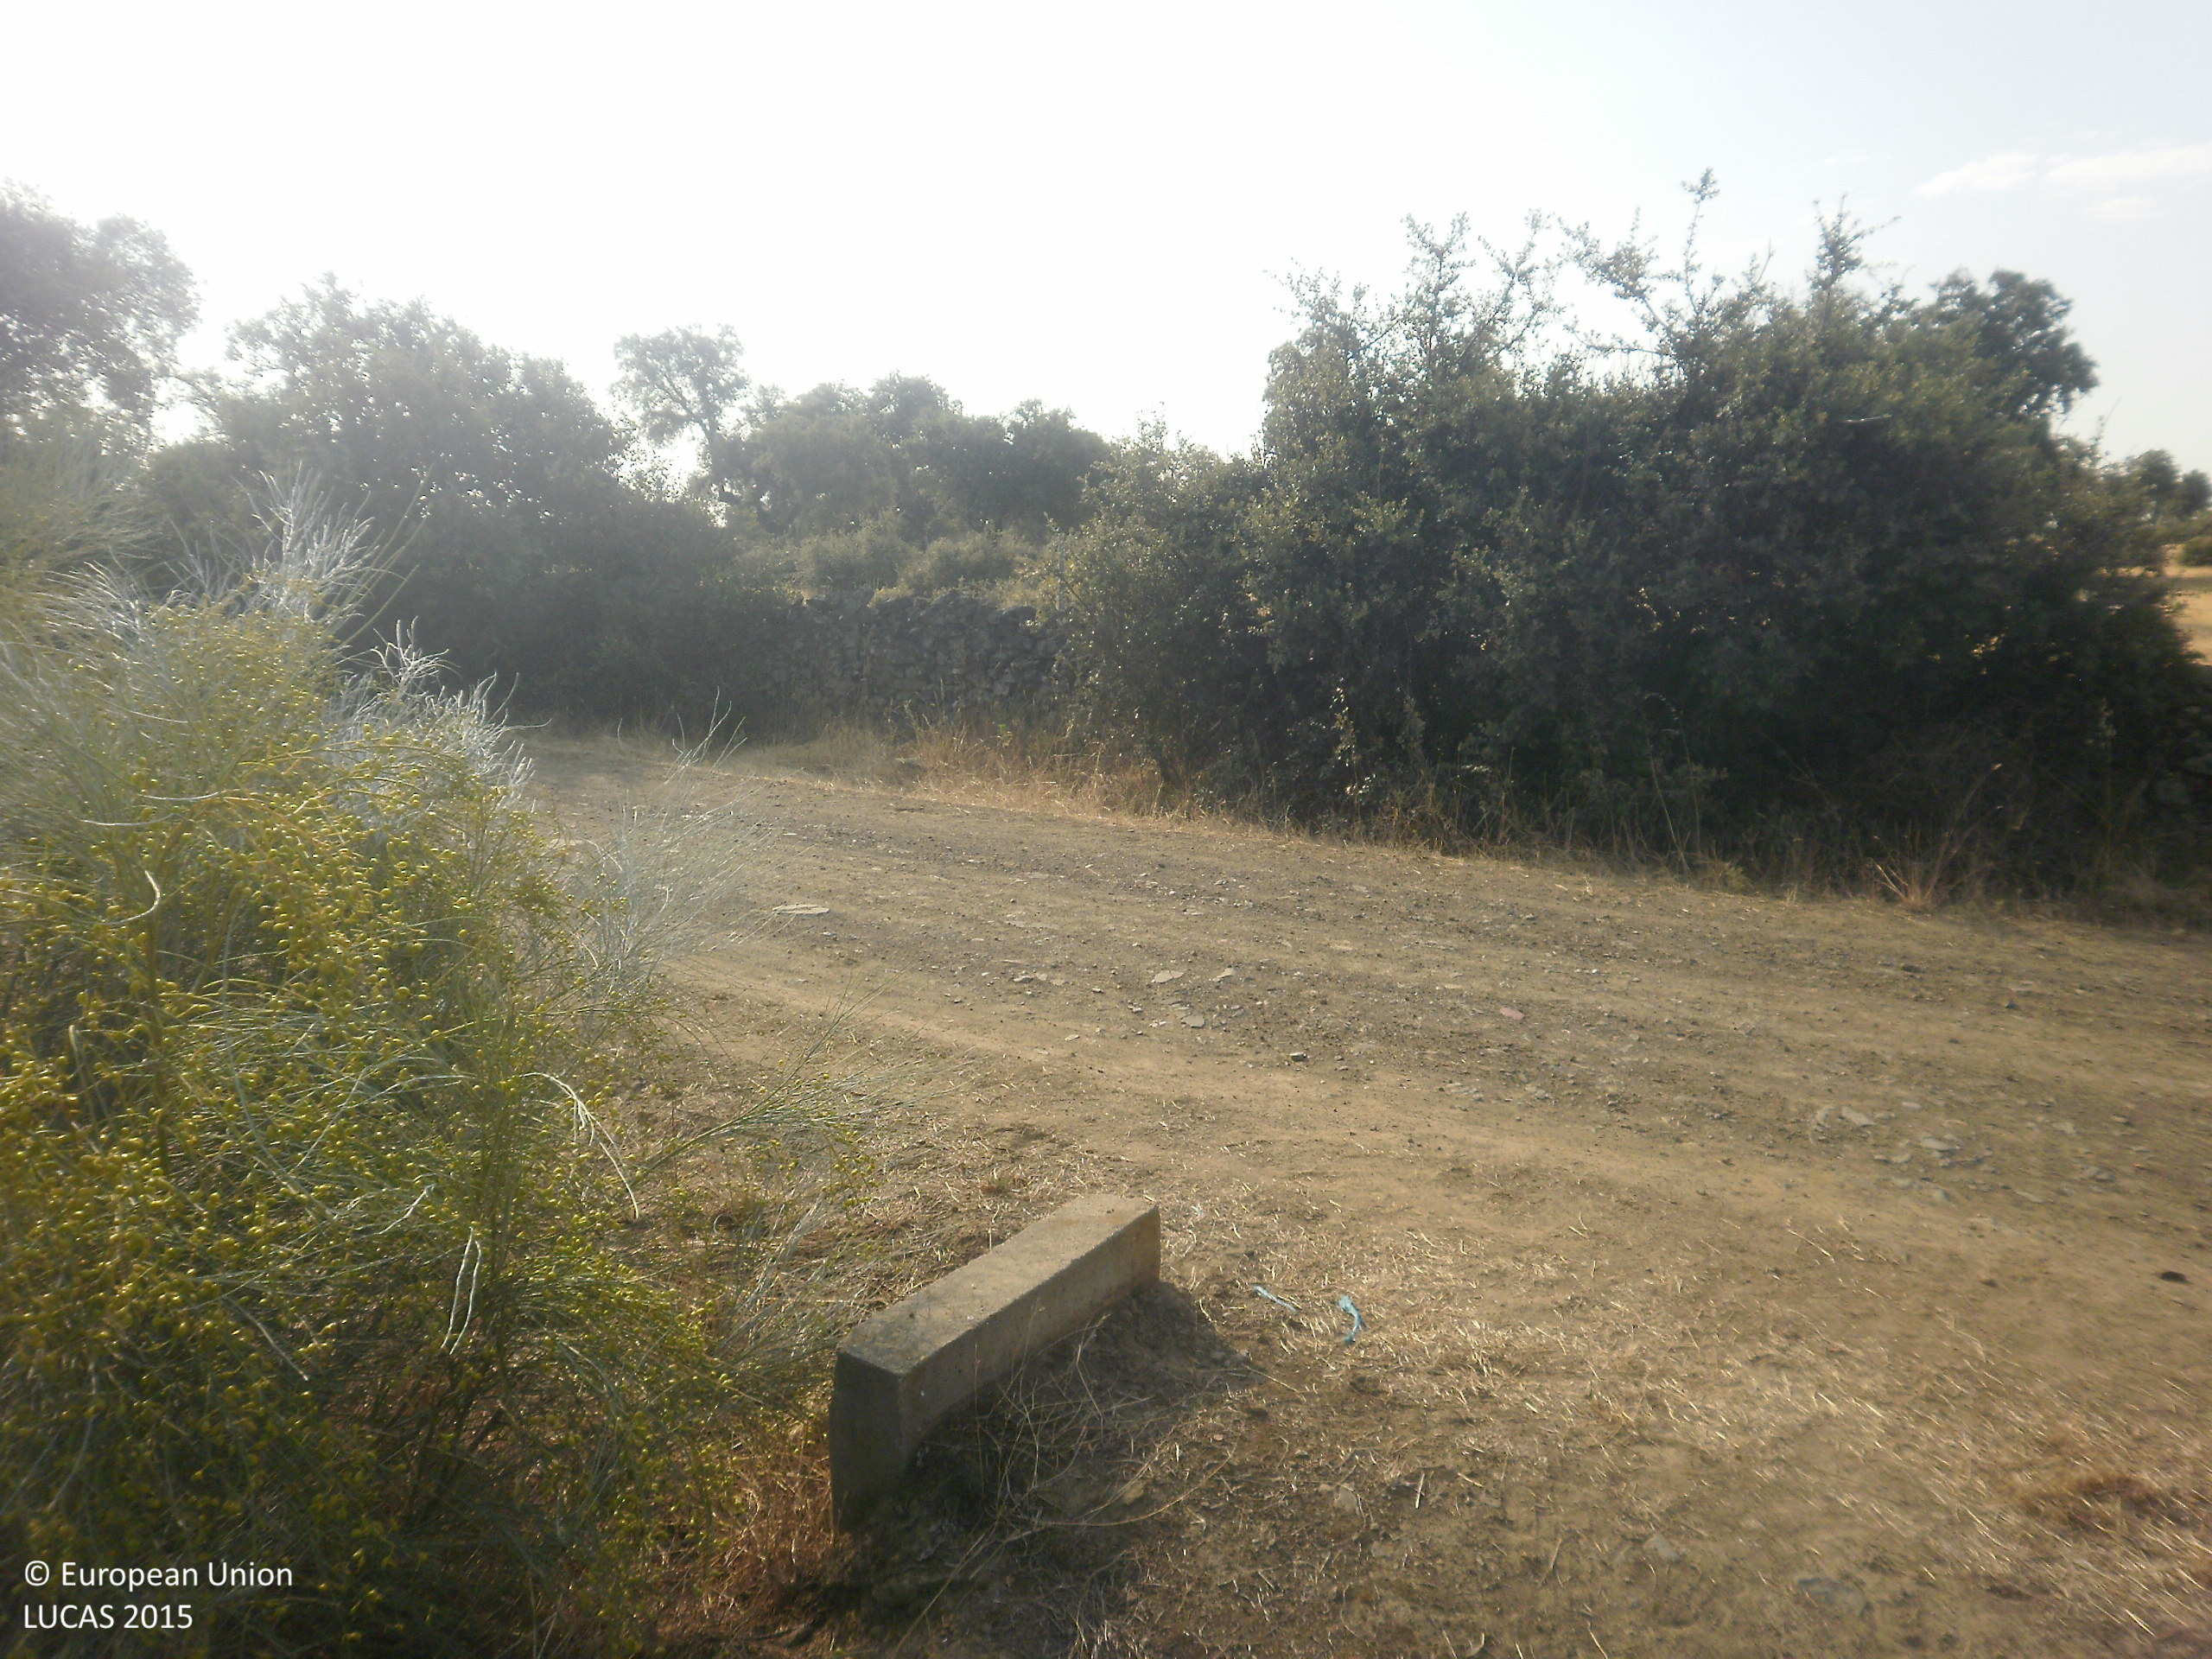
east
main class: Woodland
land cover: Broadleaved woodland
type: broadleaved evergreen forest
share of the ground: 10 - 25 %
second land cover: Grassland without tree/shrub cover
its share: 50 - 75 %
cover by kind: herbaceous plants 75 %, broadleaved forest trees 25 %
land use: Forestry
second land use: Agriculture (excluding fallow land and kitchen gardens)
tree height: > 5 m
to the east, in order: Broadleaved woodland; Grassland without tree/shrub cover; Fences; Grassland without tree/shrub cover; Artificial constructions in urban areas; Tracks; Broadleaved woodland; Fences; Tracks; Fences; Grassland without tree/shrub cover
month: June
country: ES
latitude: 39.2285
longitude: -5.8426
